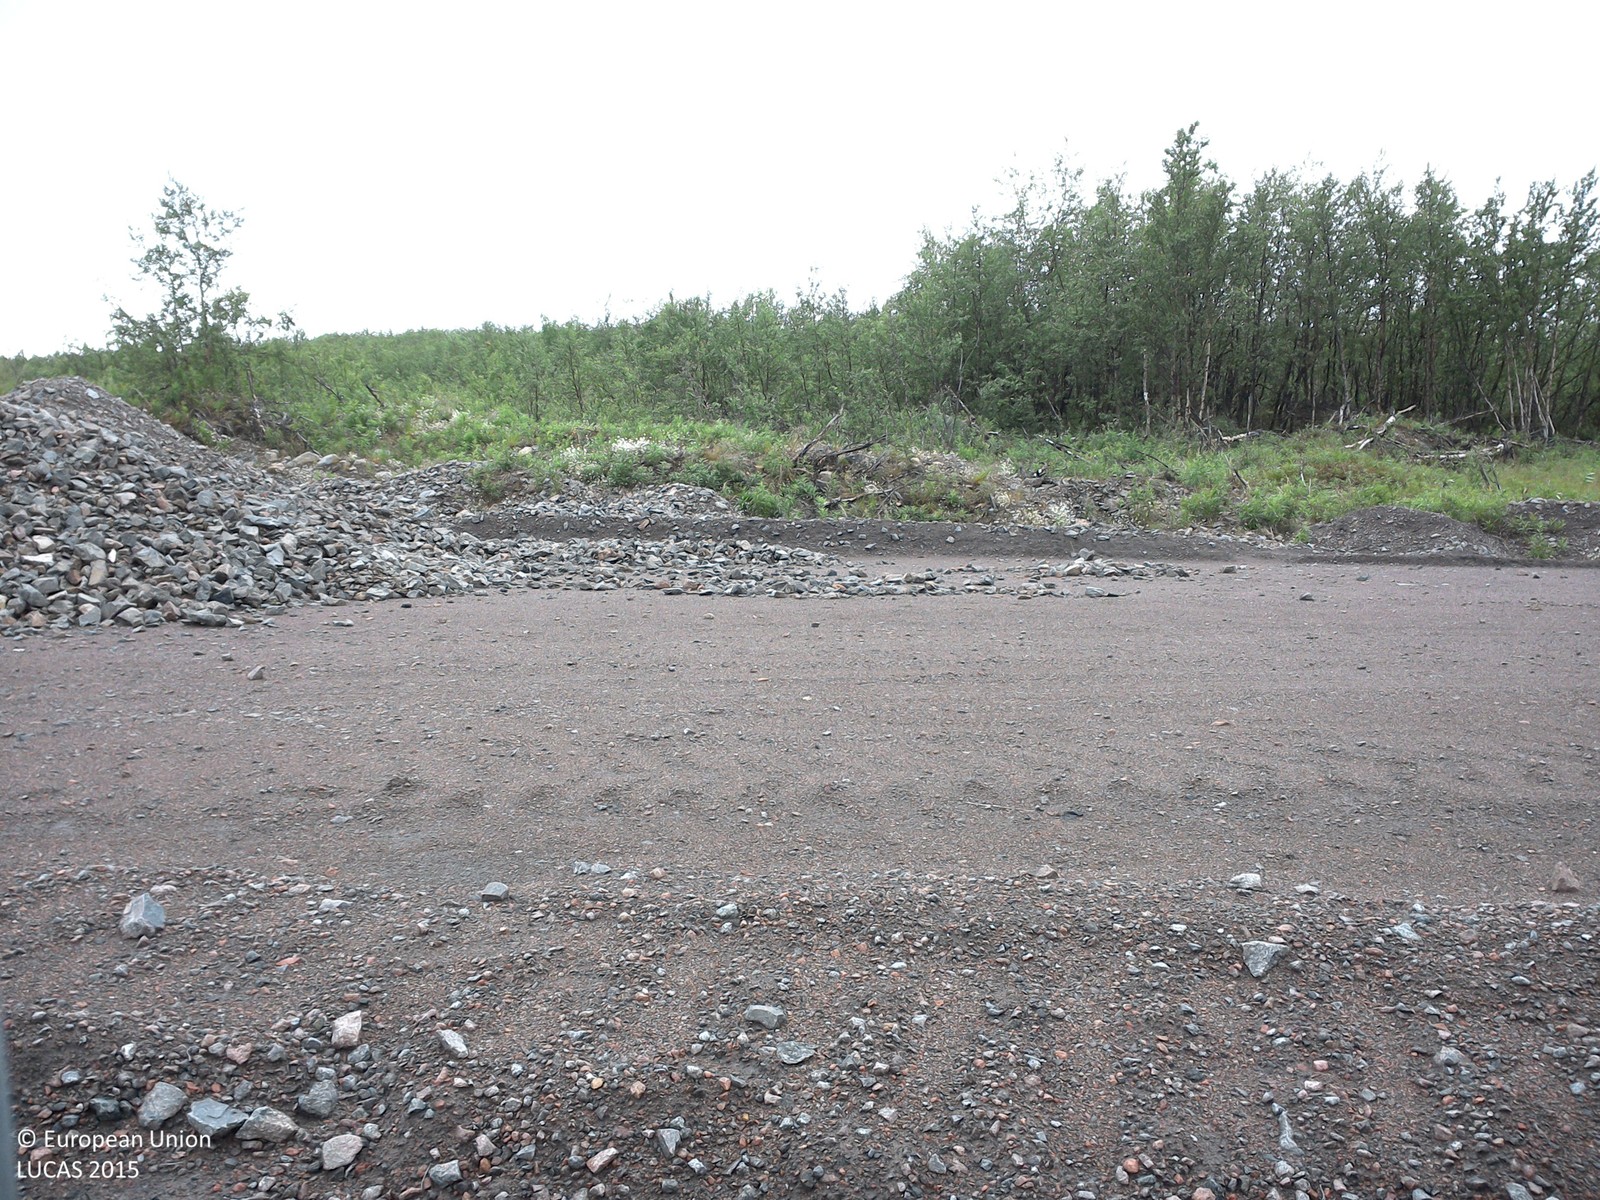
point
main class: Woodland
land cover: Broadleaved woodland
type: boreal forest
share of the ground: 25 - 50 %
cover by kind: shrubs 60 %, broadleaved forest trees 40 %
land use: Mining and quarrying
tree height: < 5 m
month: August
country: SE
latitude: 67.8138
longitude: 20.2147
